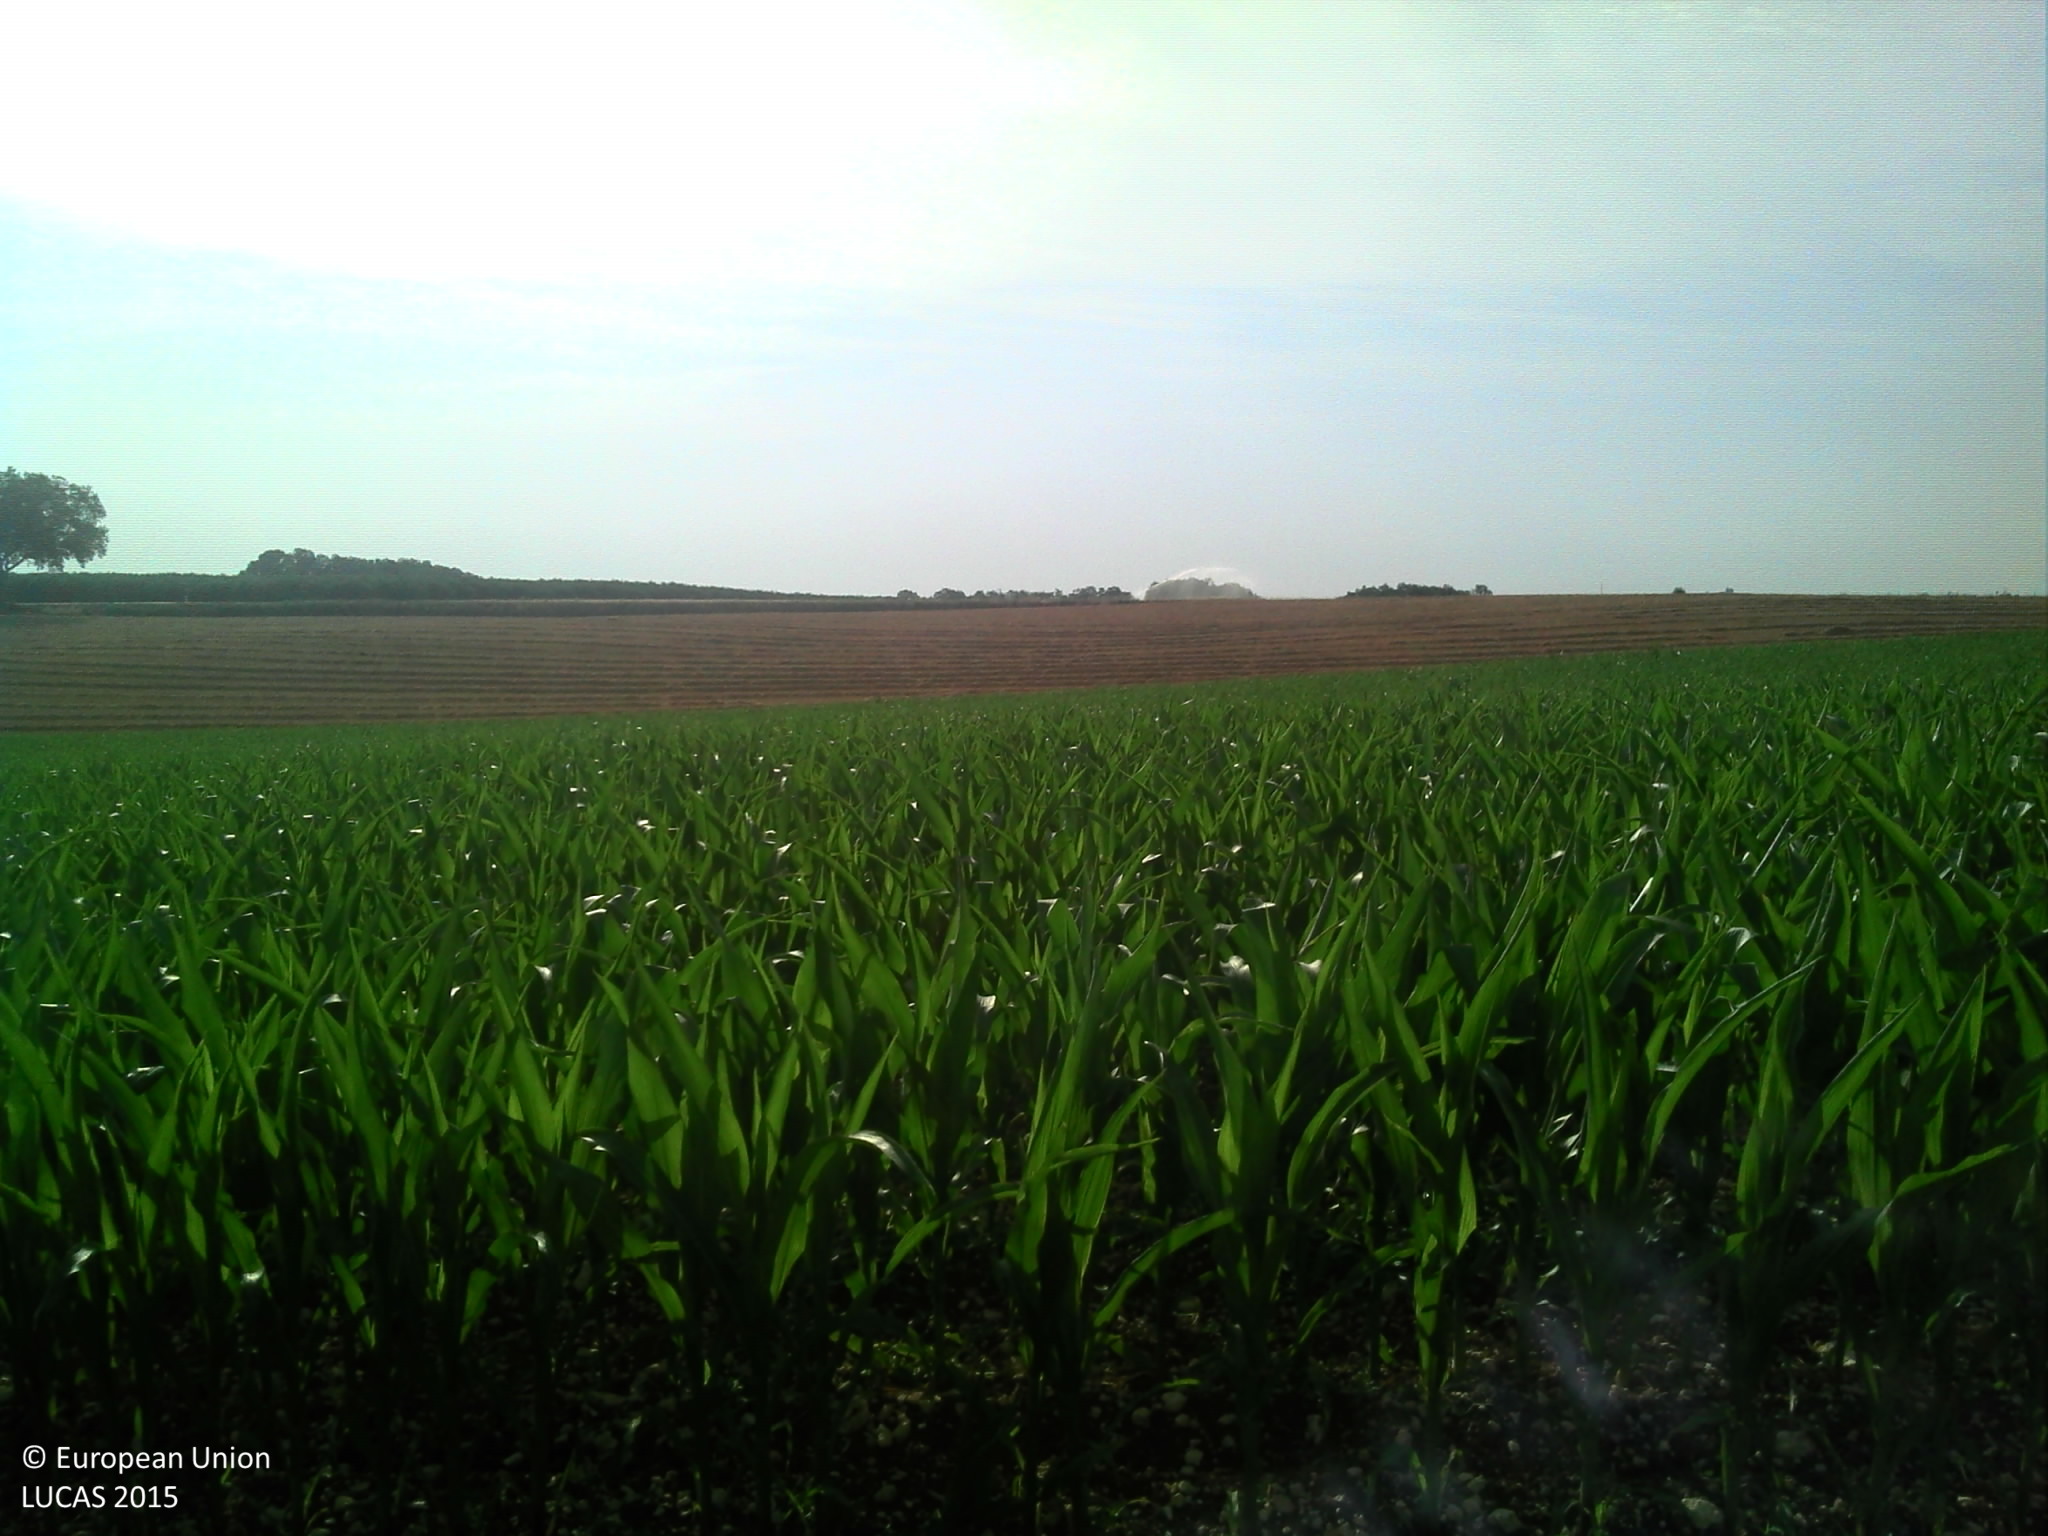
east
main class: Cropland
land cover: Maize
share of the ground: > 75 %
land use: Agriculture (excluding fallow land and kitchen gardens)
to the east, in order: Maize; Common wheat; Grass margins
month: July
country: FR
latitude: 44.3335
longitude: 0.9285
